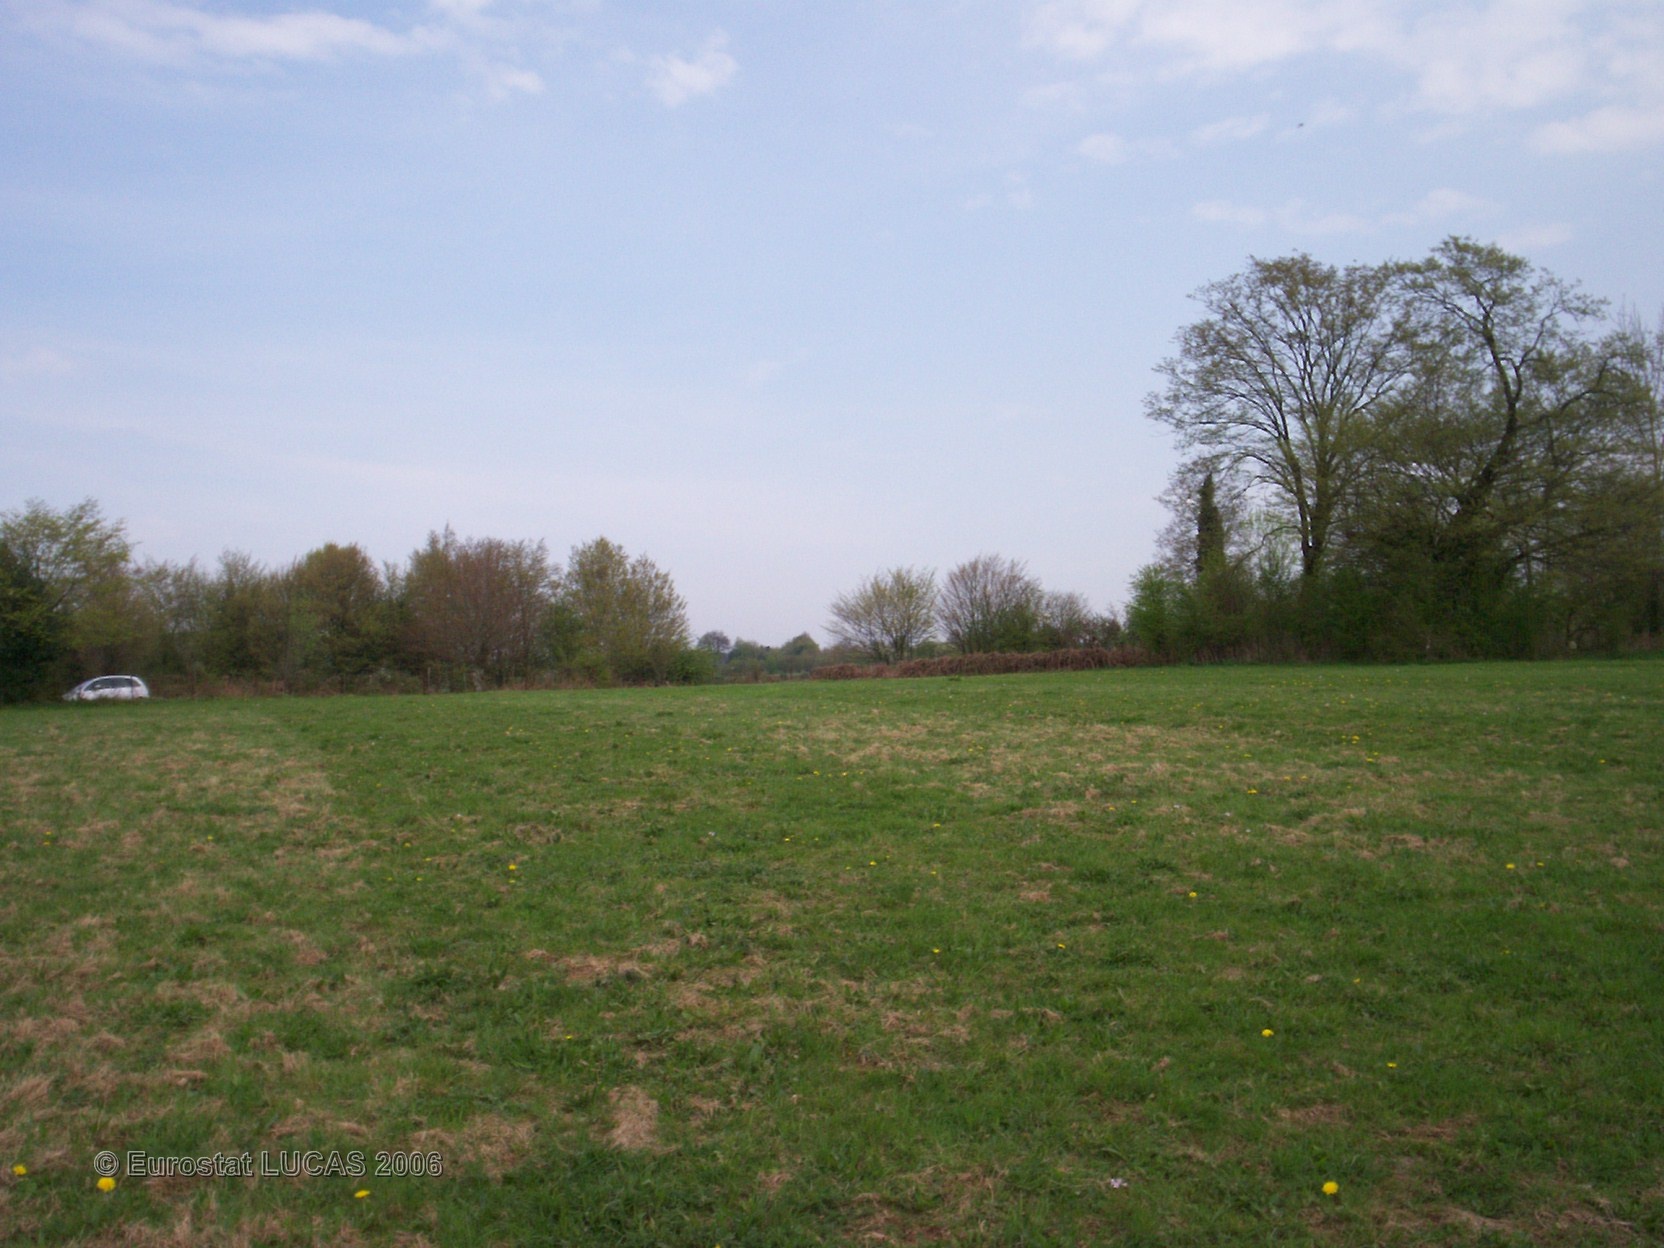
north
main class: Grassland
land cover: Grassland without tree/shrub cover
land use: Agriculture (excluding fallow land and kitchen gardens)
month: May
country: FR
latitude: 49.9334
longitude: 4.2973
